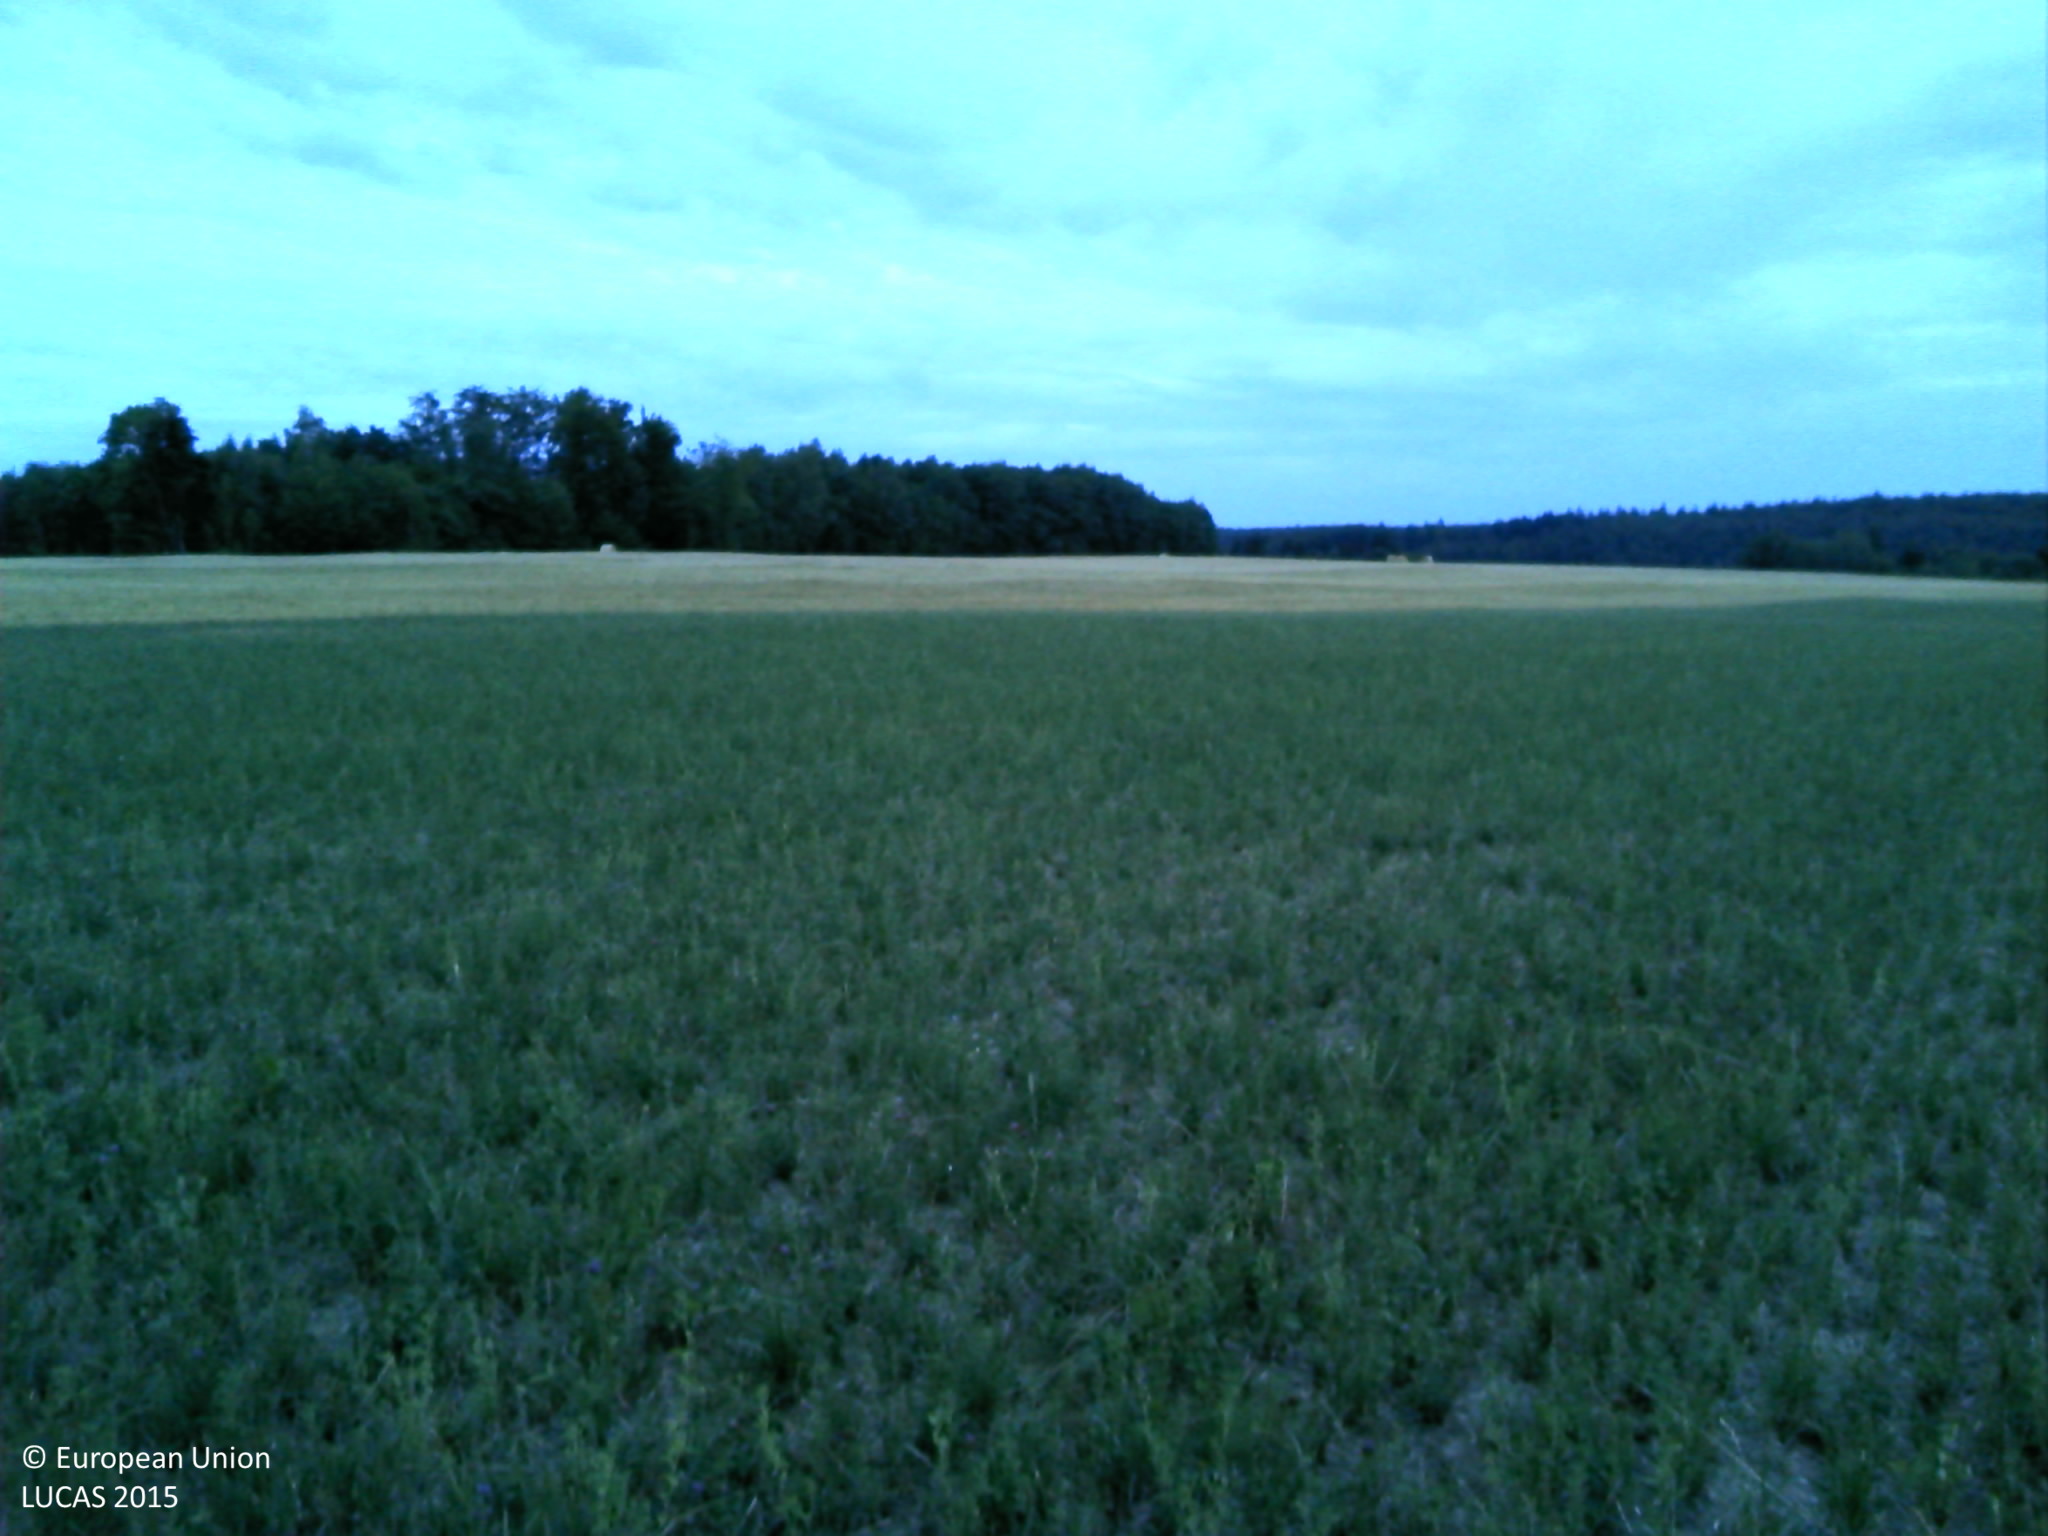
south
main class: Grassland
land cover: Grassland without tree/shrub cover
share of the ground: 50 - 75 %
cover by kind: herbaceous plants 100 %
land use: Agriculture (excluding fallow land and kitchen gardens)
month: August
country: FR
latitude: 48.1238
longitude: 6.2524
